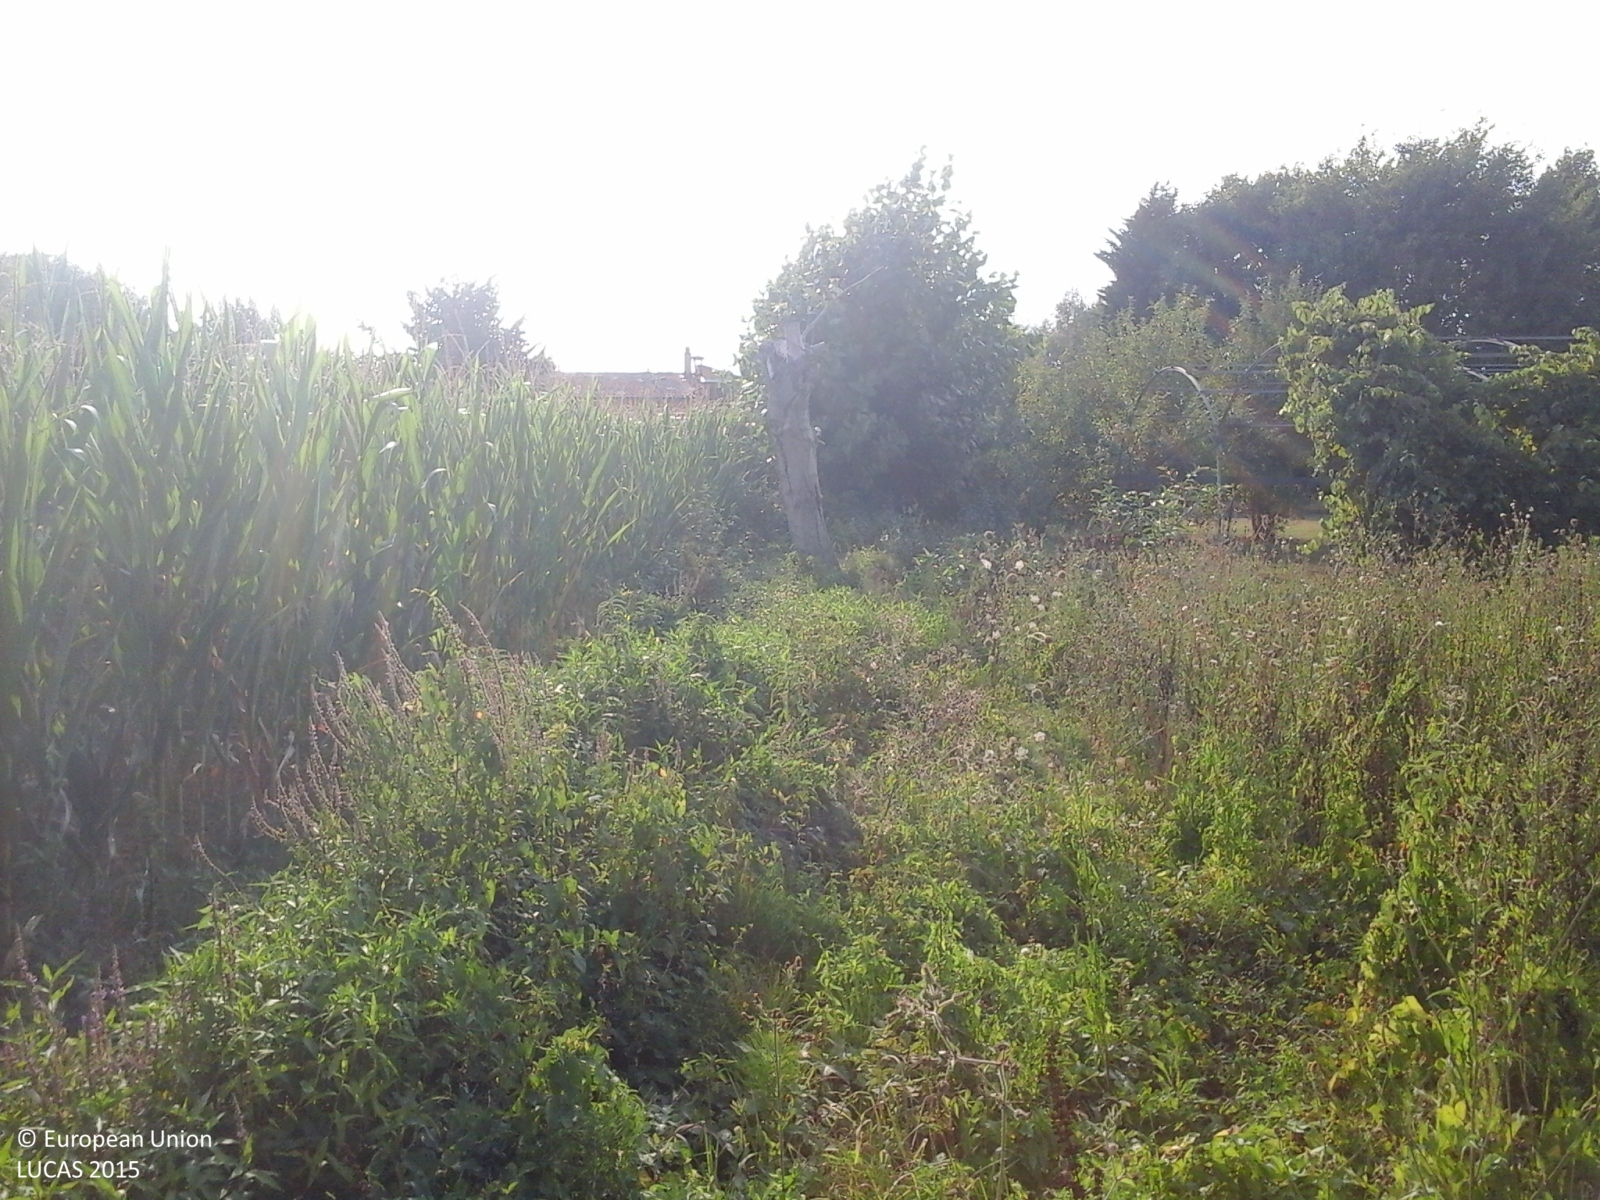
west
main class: Cropland
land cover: Maize
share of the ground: > 75 %
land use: Agriculture (excluding fallow land and kitchen gardens)
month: August
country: IT
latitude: 43.8438
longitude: 10.5831
